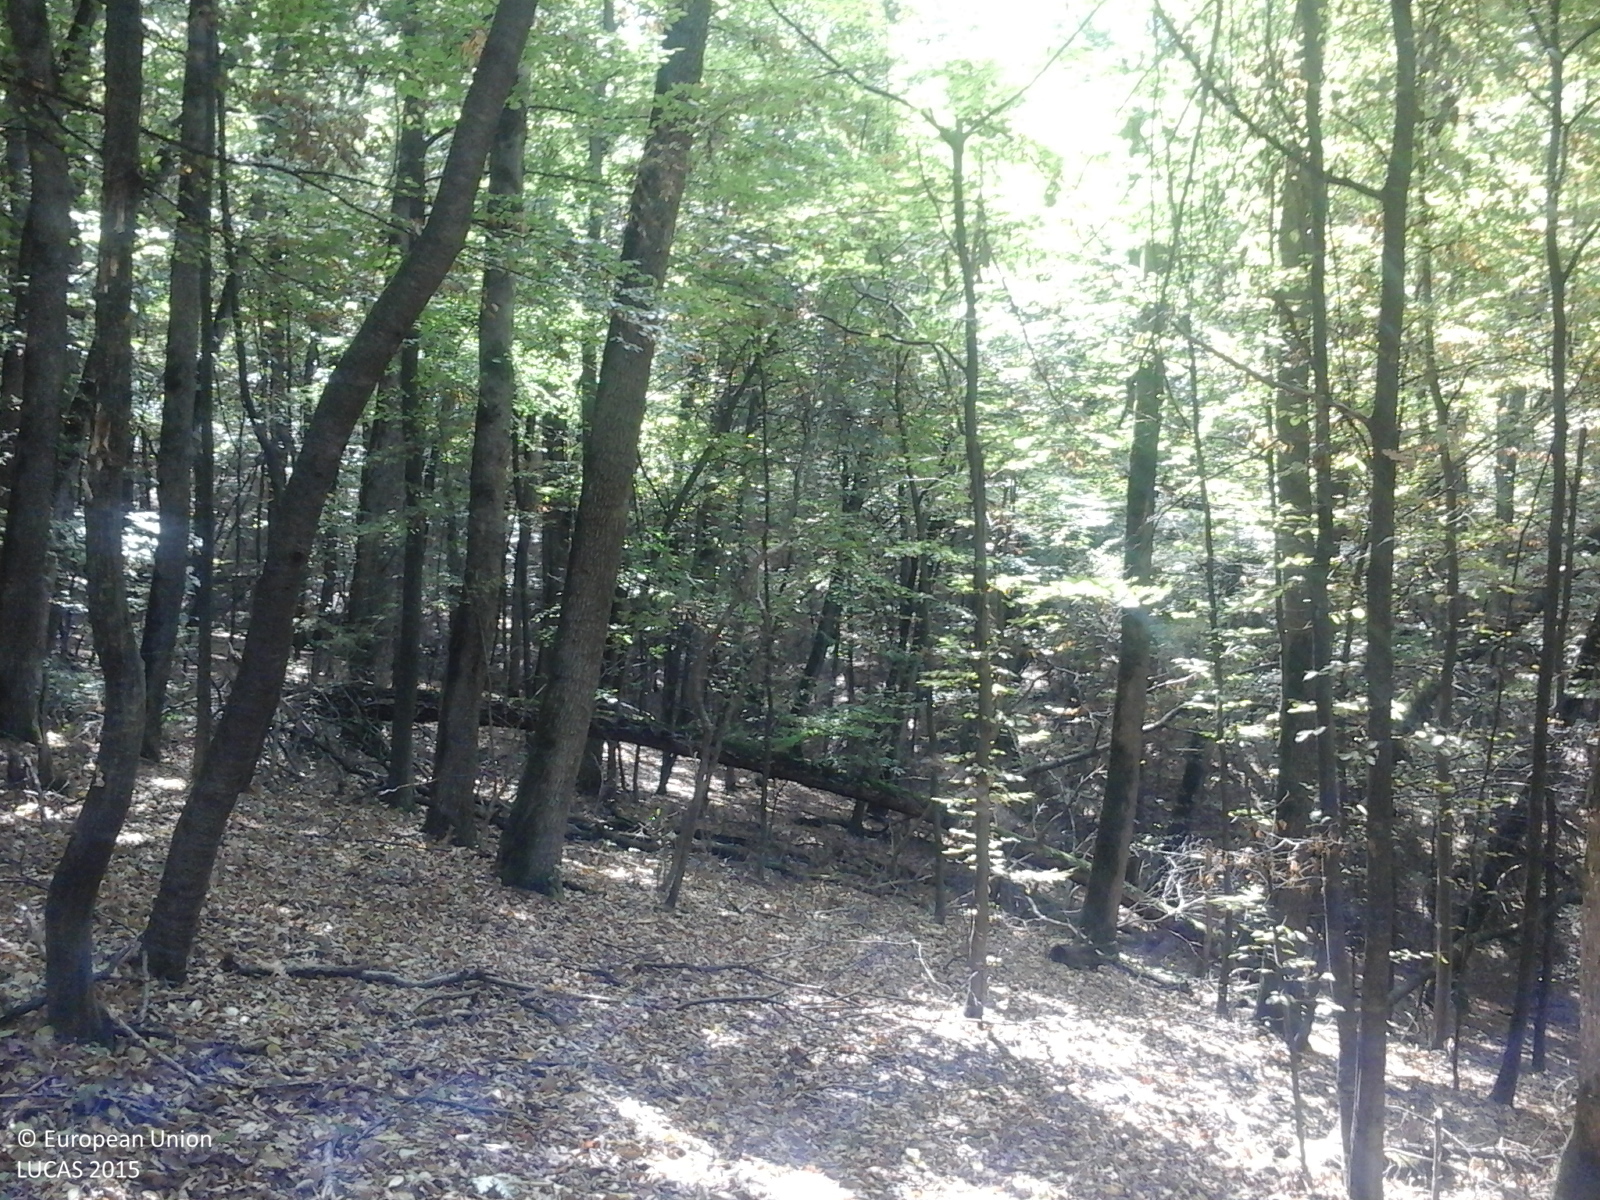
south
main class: Woodland
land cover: Broadleaved woodland
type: beech forest
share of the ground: > 75 %
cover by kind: broadleaved forest trees 100 %
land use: Forestry
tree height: > 5 m
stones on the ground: 10 - 25 %
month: August
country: RO
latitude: 45.2911
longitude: 21.6744
